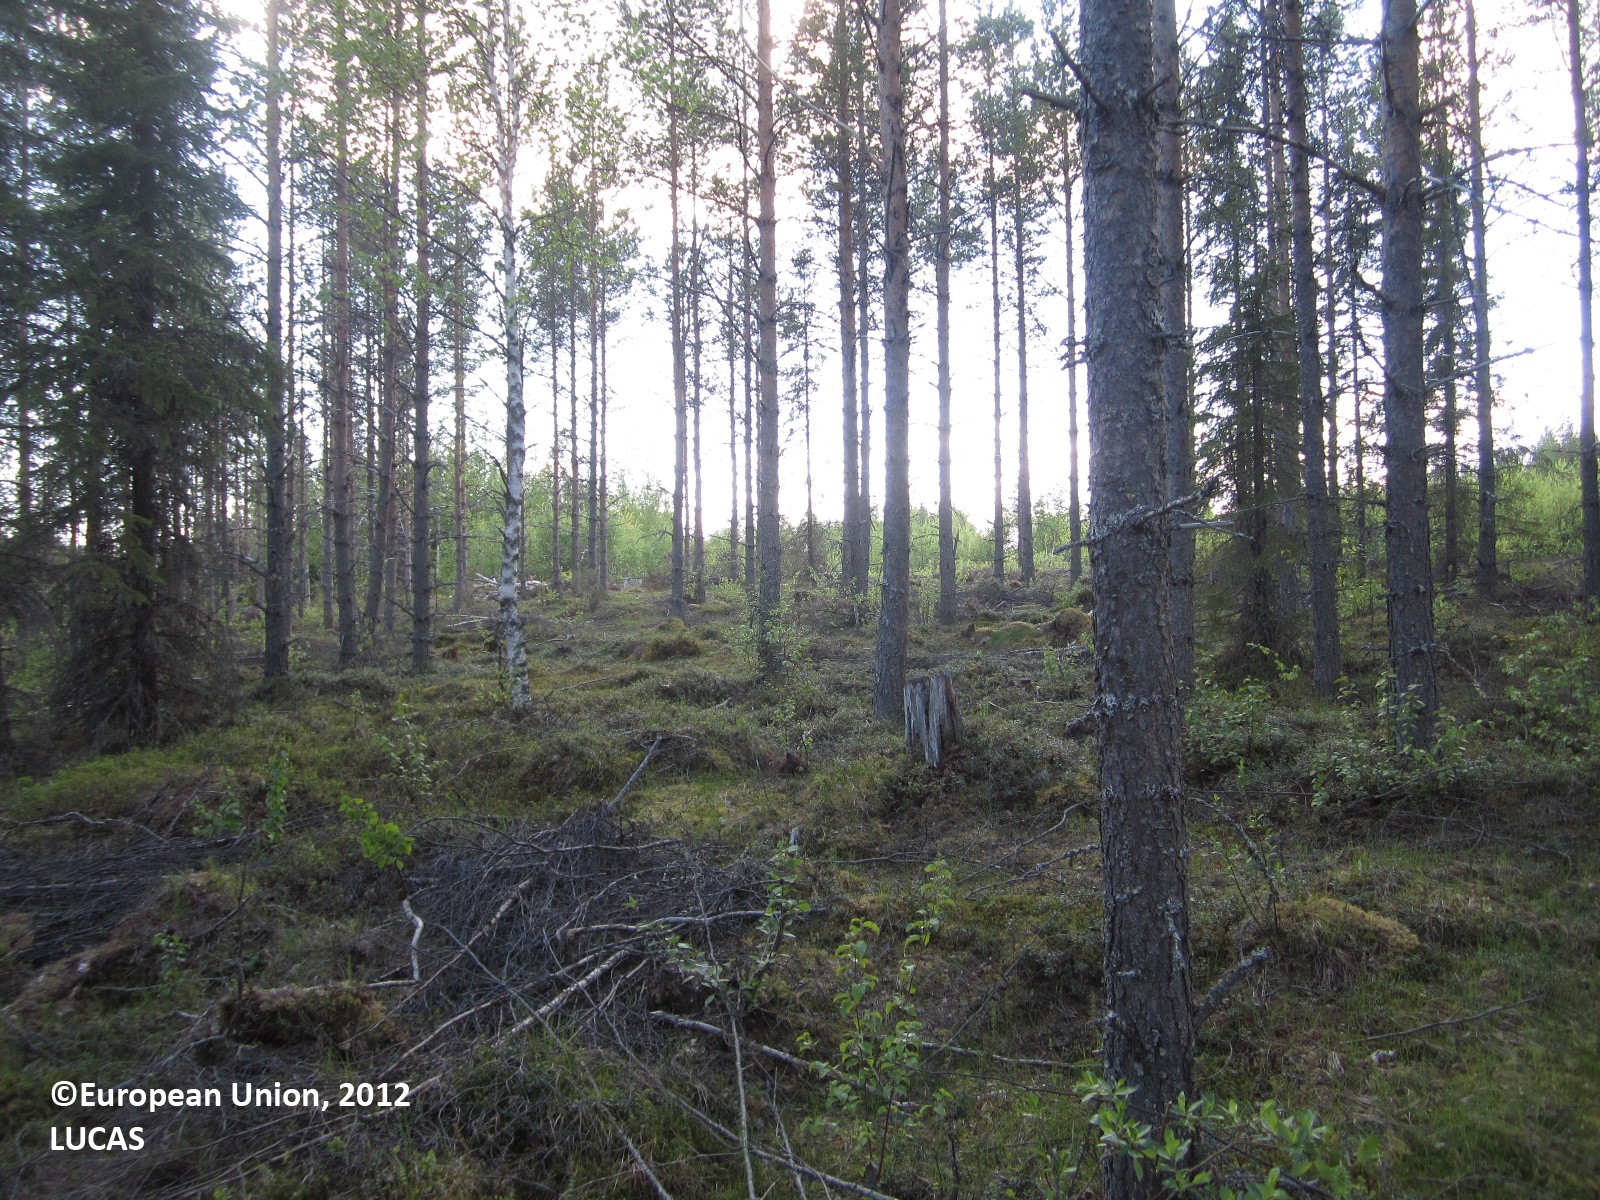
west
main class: Woodland
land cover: Pine dominated mixed woodland
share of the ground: 25 - 50 %
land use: Forestry
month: June
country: FI
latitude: 64.6422
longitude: 28.7887
